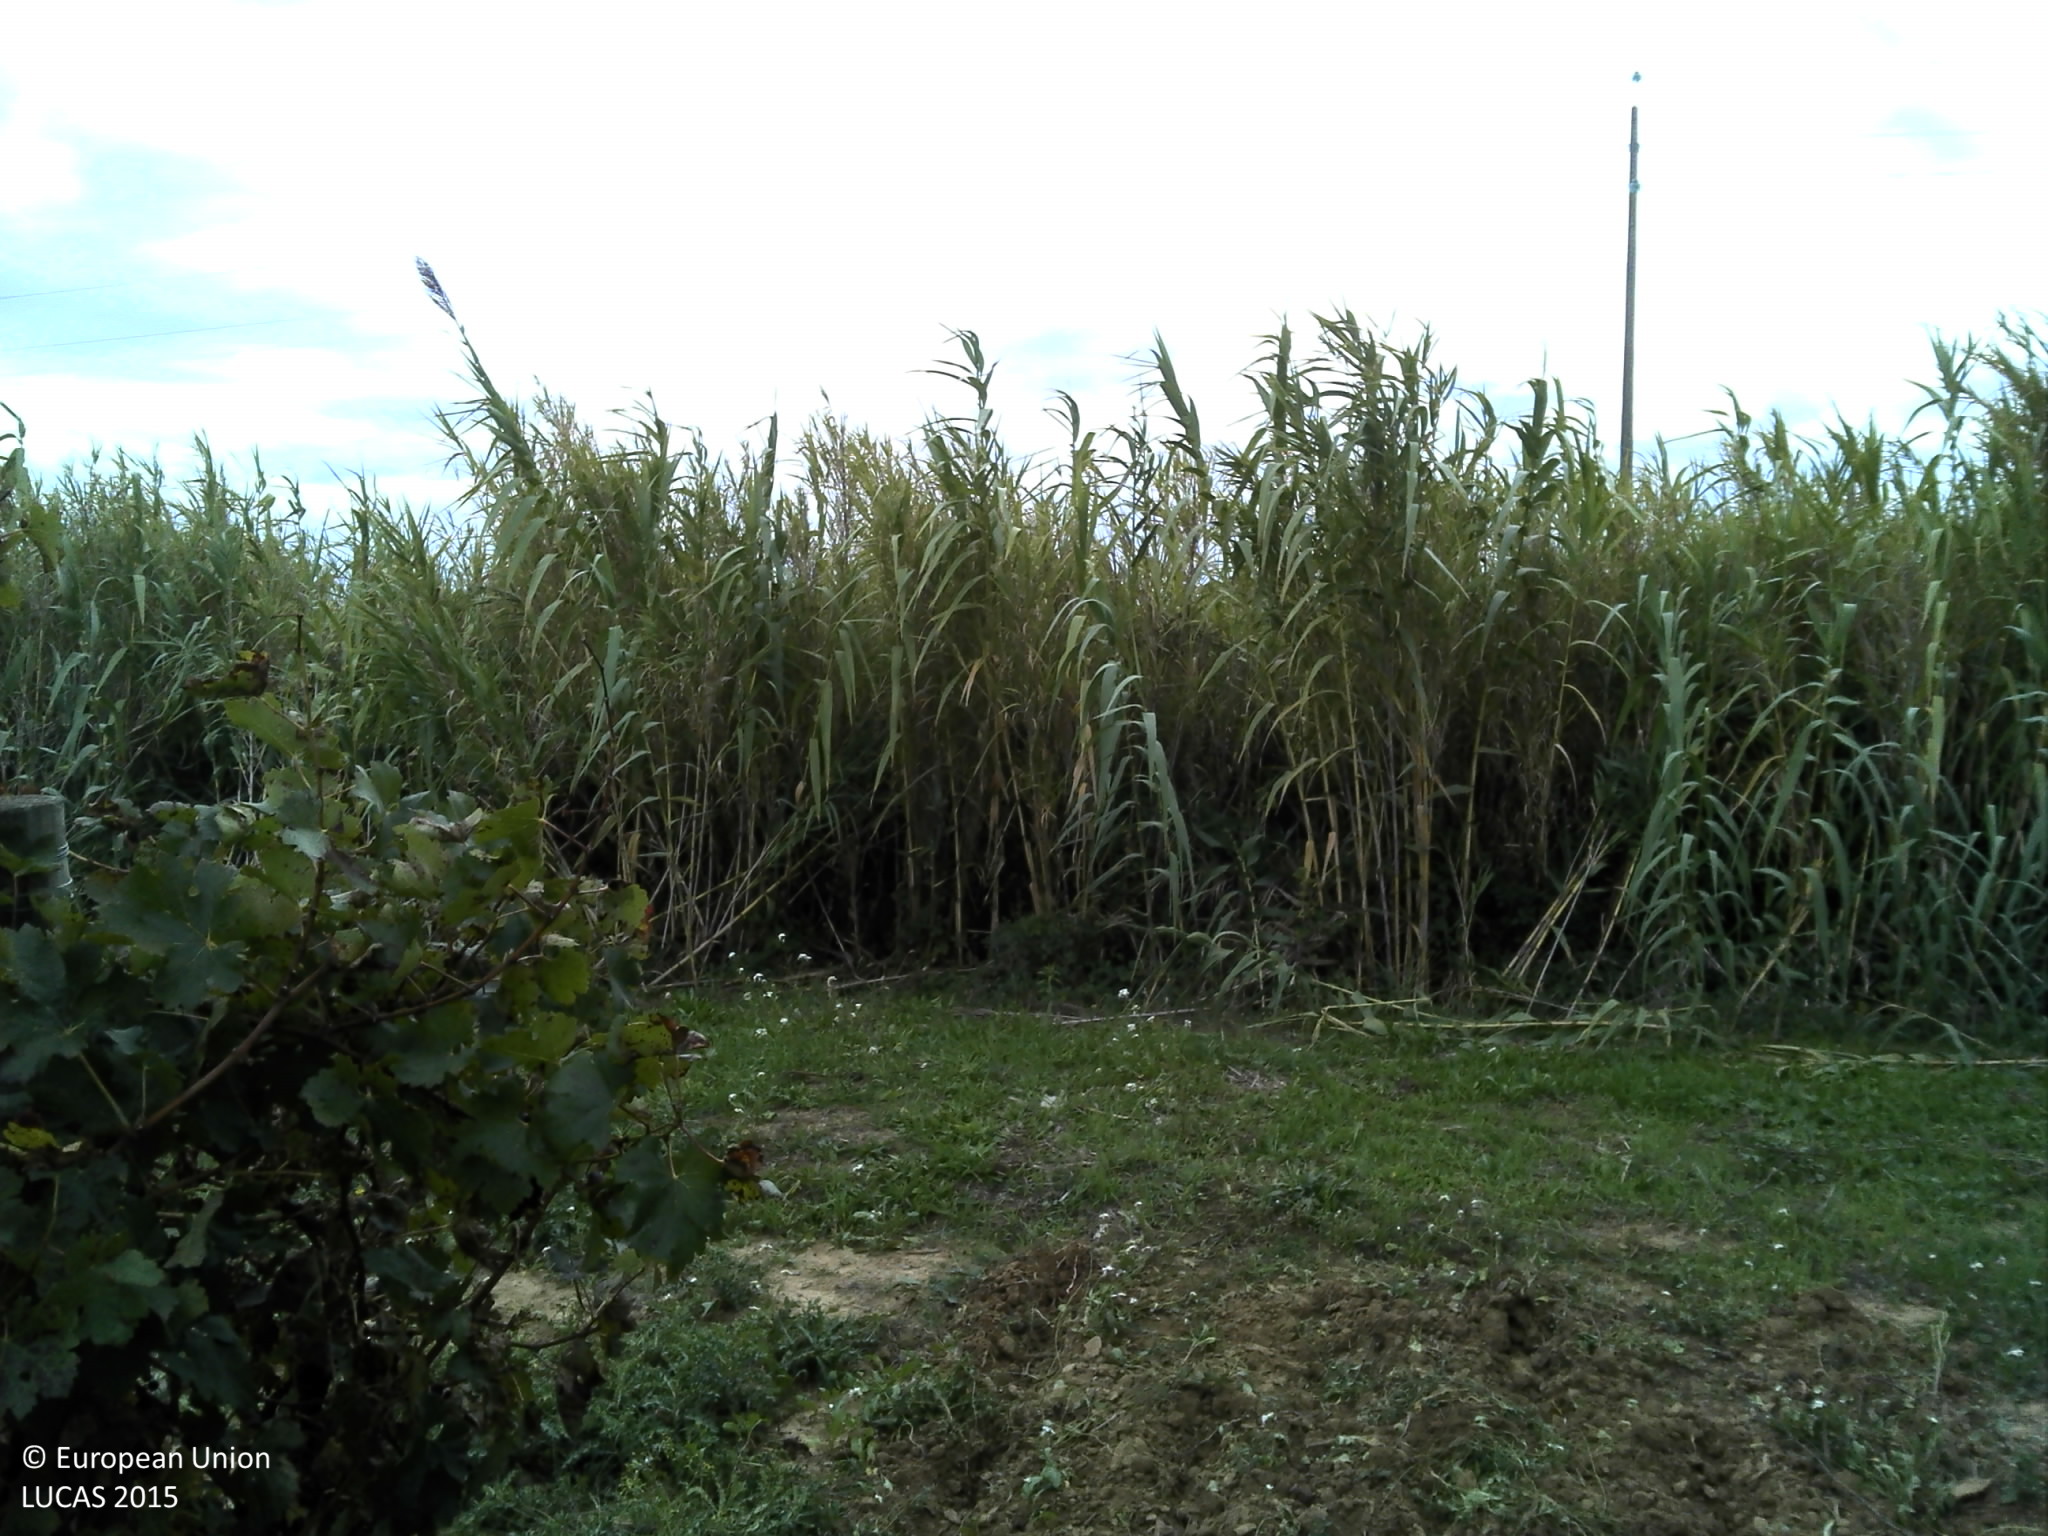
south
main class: Cropland
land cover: Vineyards
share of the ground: 10 - 25 %
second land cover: Other bare soil
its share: > 75 %
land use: Agriculture (excluding fallow land and kitchen gardens)
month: October
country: FR
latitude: 43.3596
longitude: 3.0870
